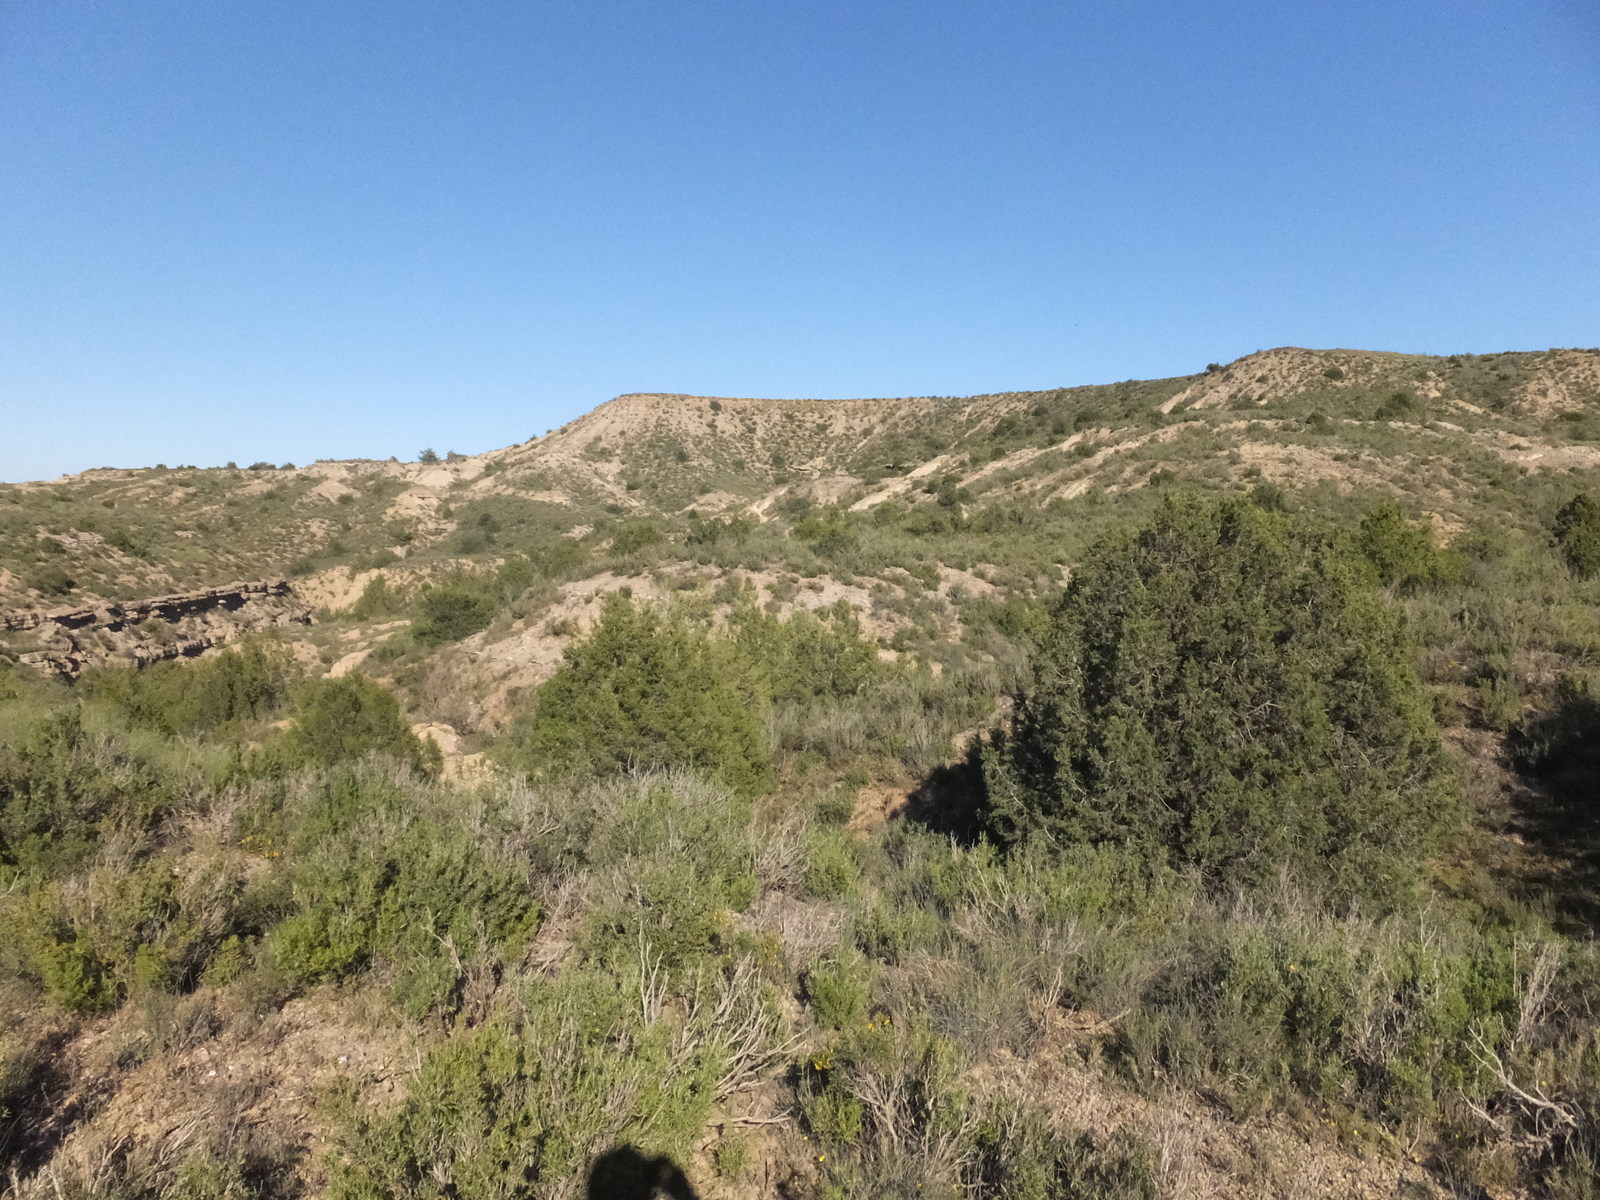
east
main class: Shrubland
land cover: Shrubland with sparse tree cover
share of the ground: > 75 %
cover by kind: shrubs 90 %, coniferous forest trees 5 %, herbaceous plants 5 %
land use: Abandoned areas
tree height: < 5 m
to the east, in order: Shrubland with sparse tree cover; Grassland with sparse tree/shrub cover; Rocks and stones; Grassland with sparse tree/shrub cover
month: April
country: ES
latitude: 41.6813
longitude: -0.2165
